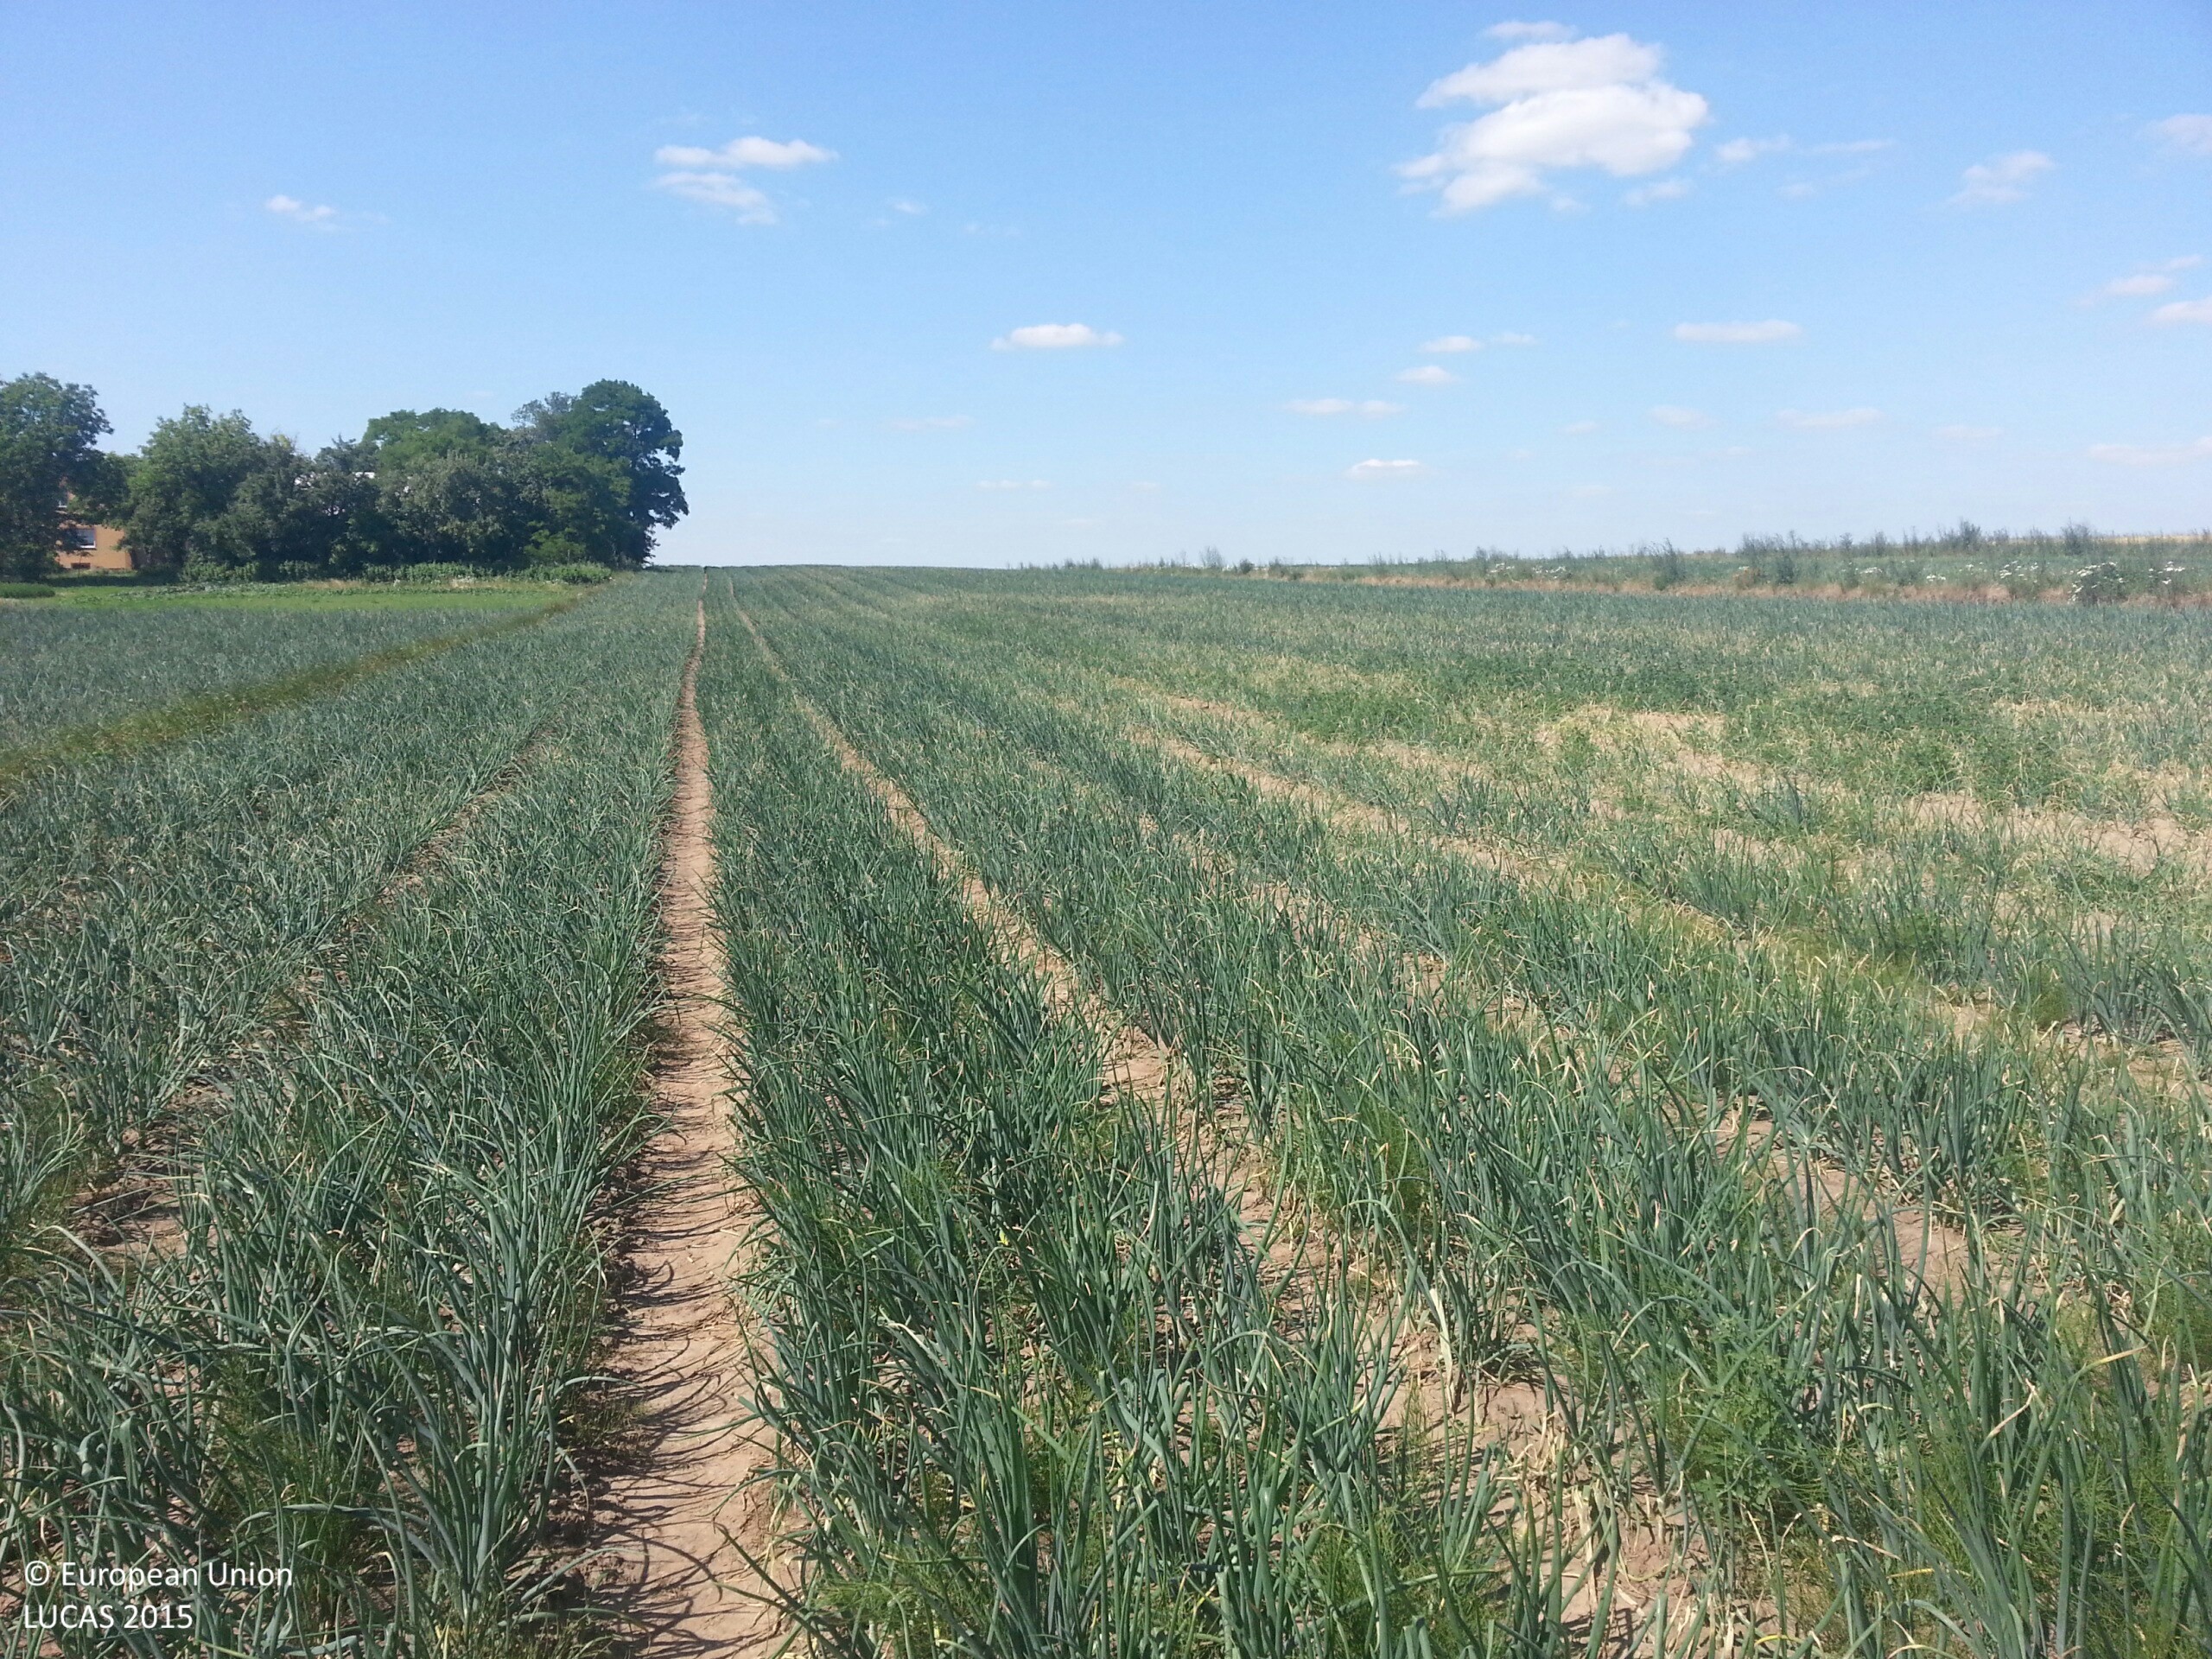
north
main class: Cropland
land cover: Other fresh vegetables
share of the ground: > 75 %
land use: Agriculture (excluding fallow land and kitchen gardens)
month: July
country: PL
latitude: 50.2715
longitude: 20.3770
